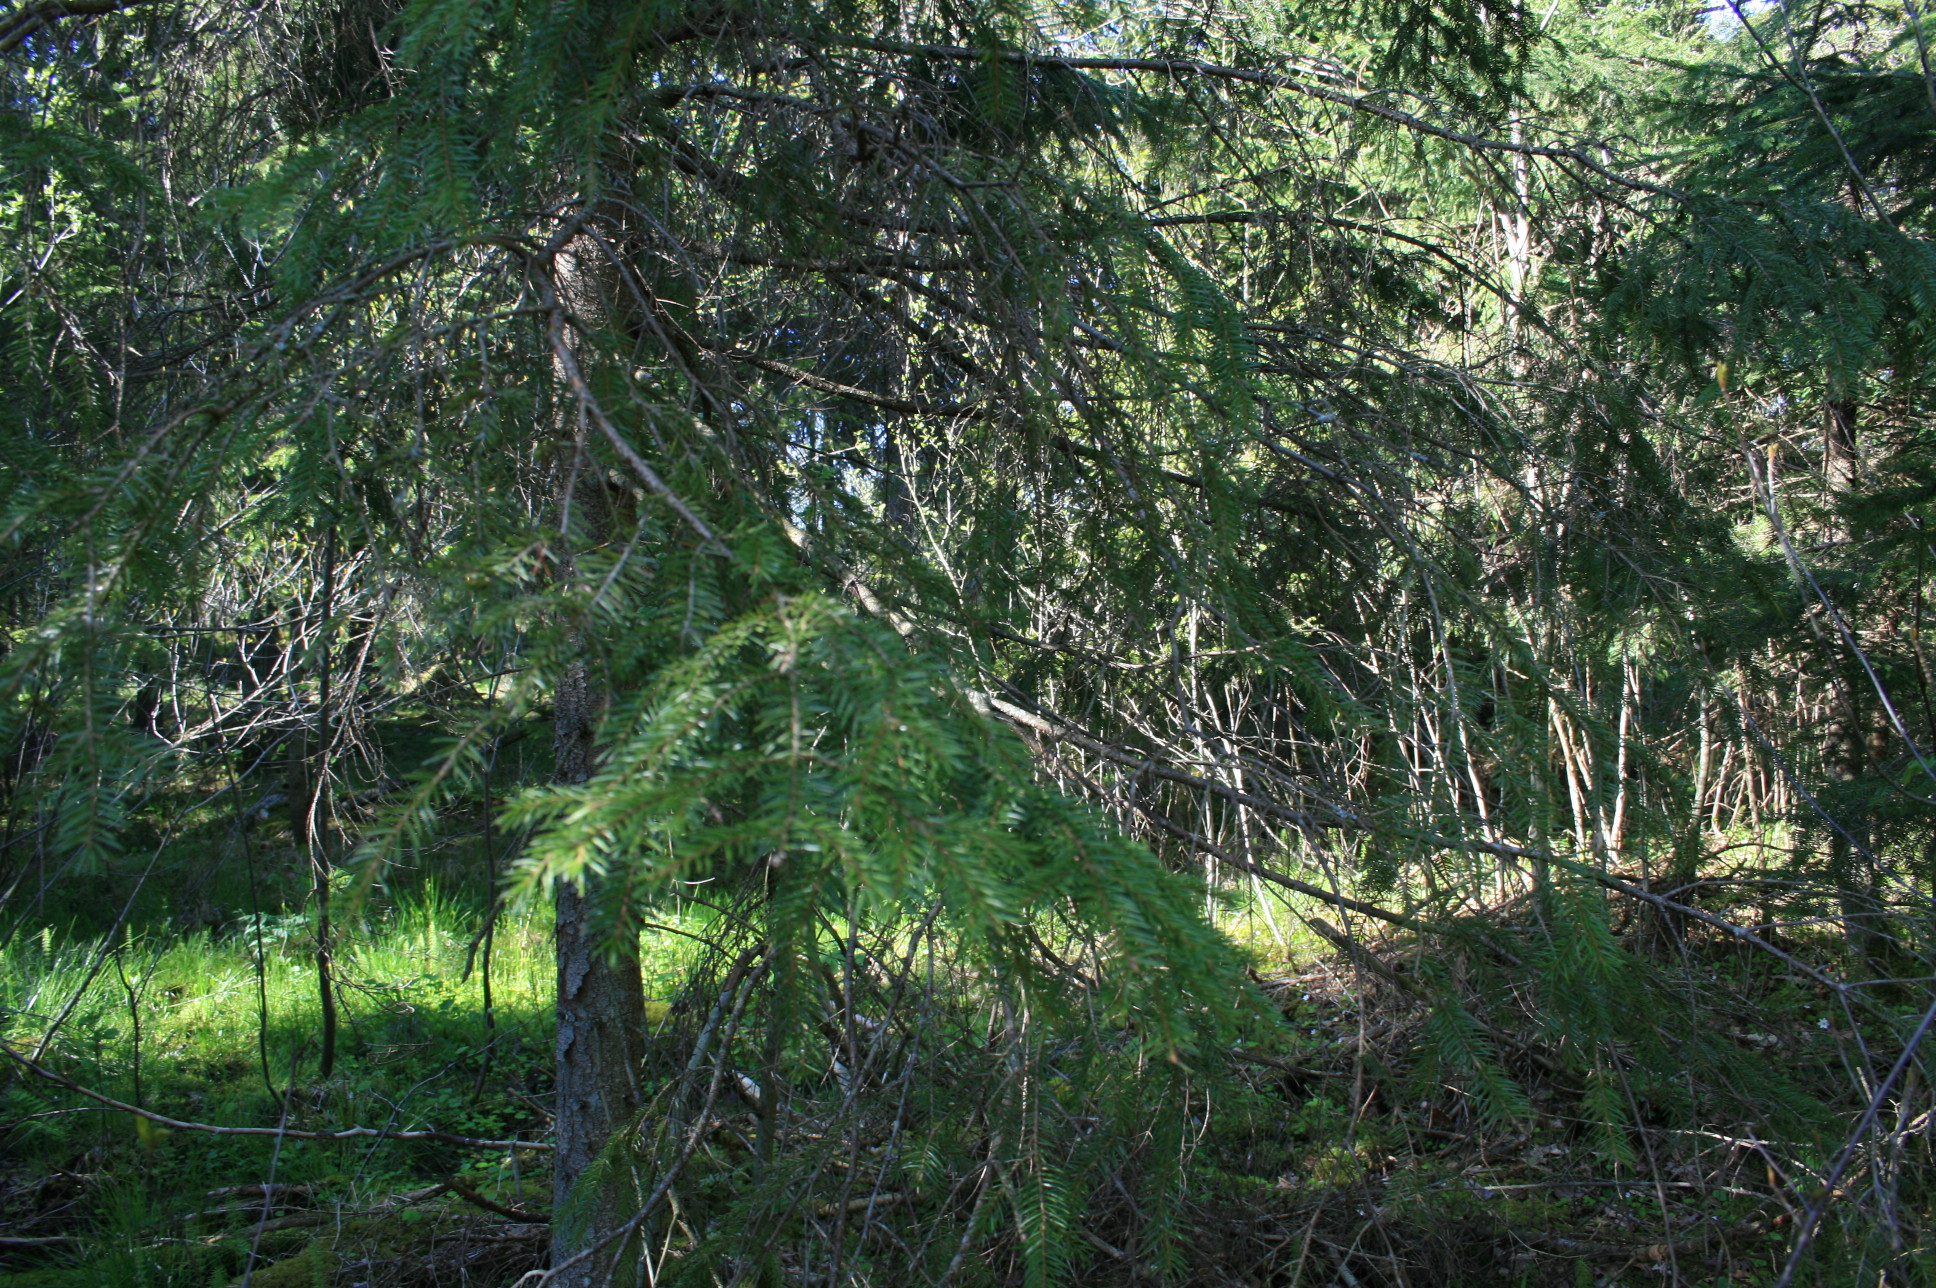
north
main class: Woodland
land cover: Other mixed woodland
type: hemiboreal forest and nemoral coniferous forest and mixed broadleaved-coniferous forest
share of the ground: > 75 %
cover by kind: coniferous forest trees 70 %, broadleaved forest trees 25 %, lichens and mosses 5 %
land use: Forestry
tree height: > 5 m
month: May
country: LT
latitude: 55.9805
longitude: 21.4708
